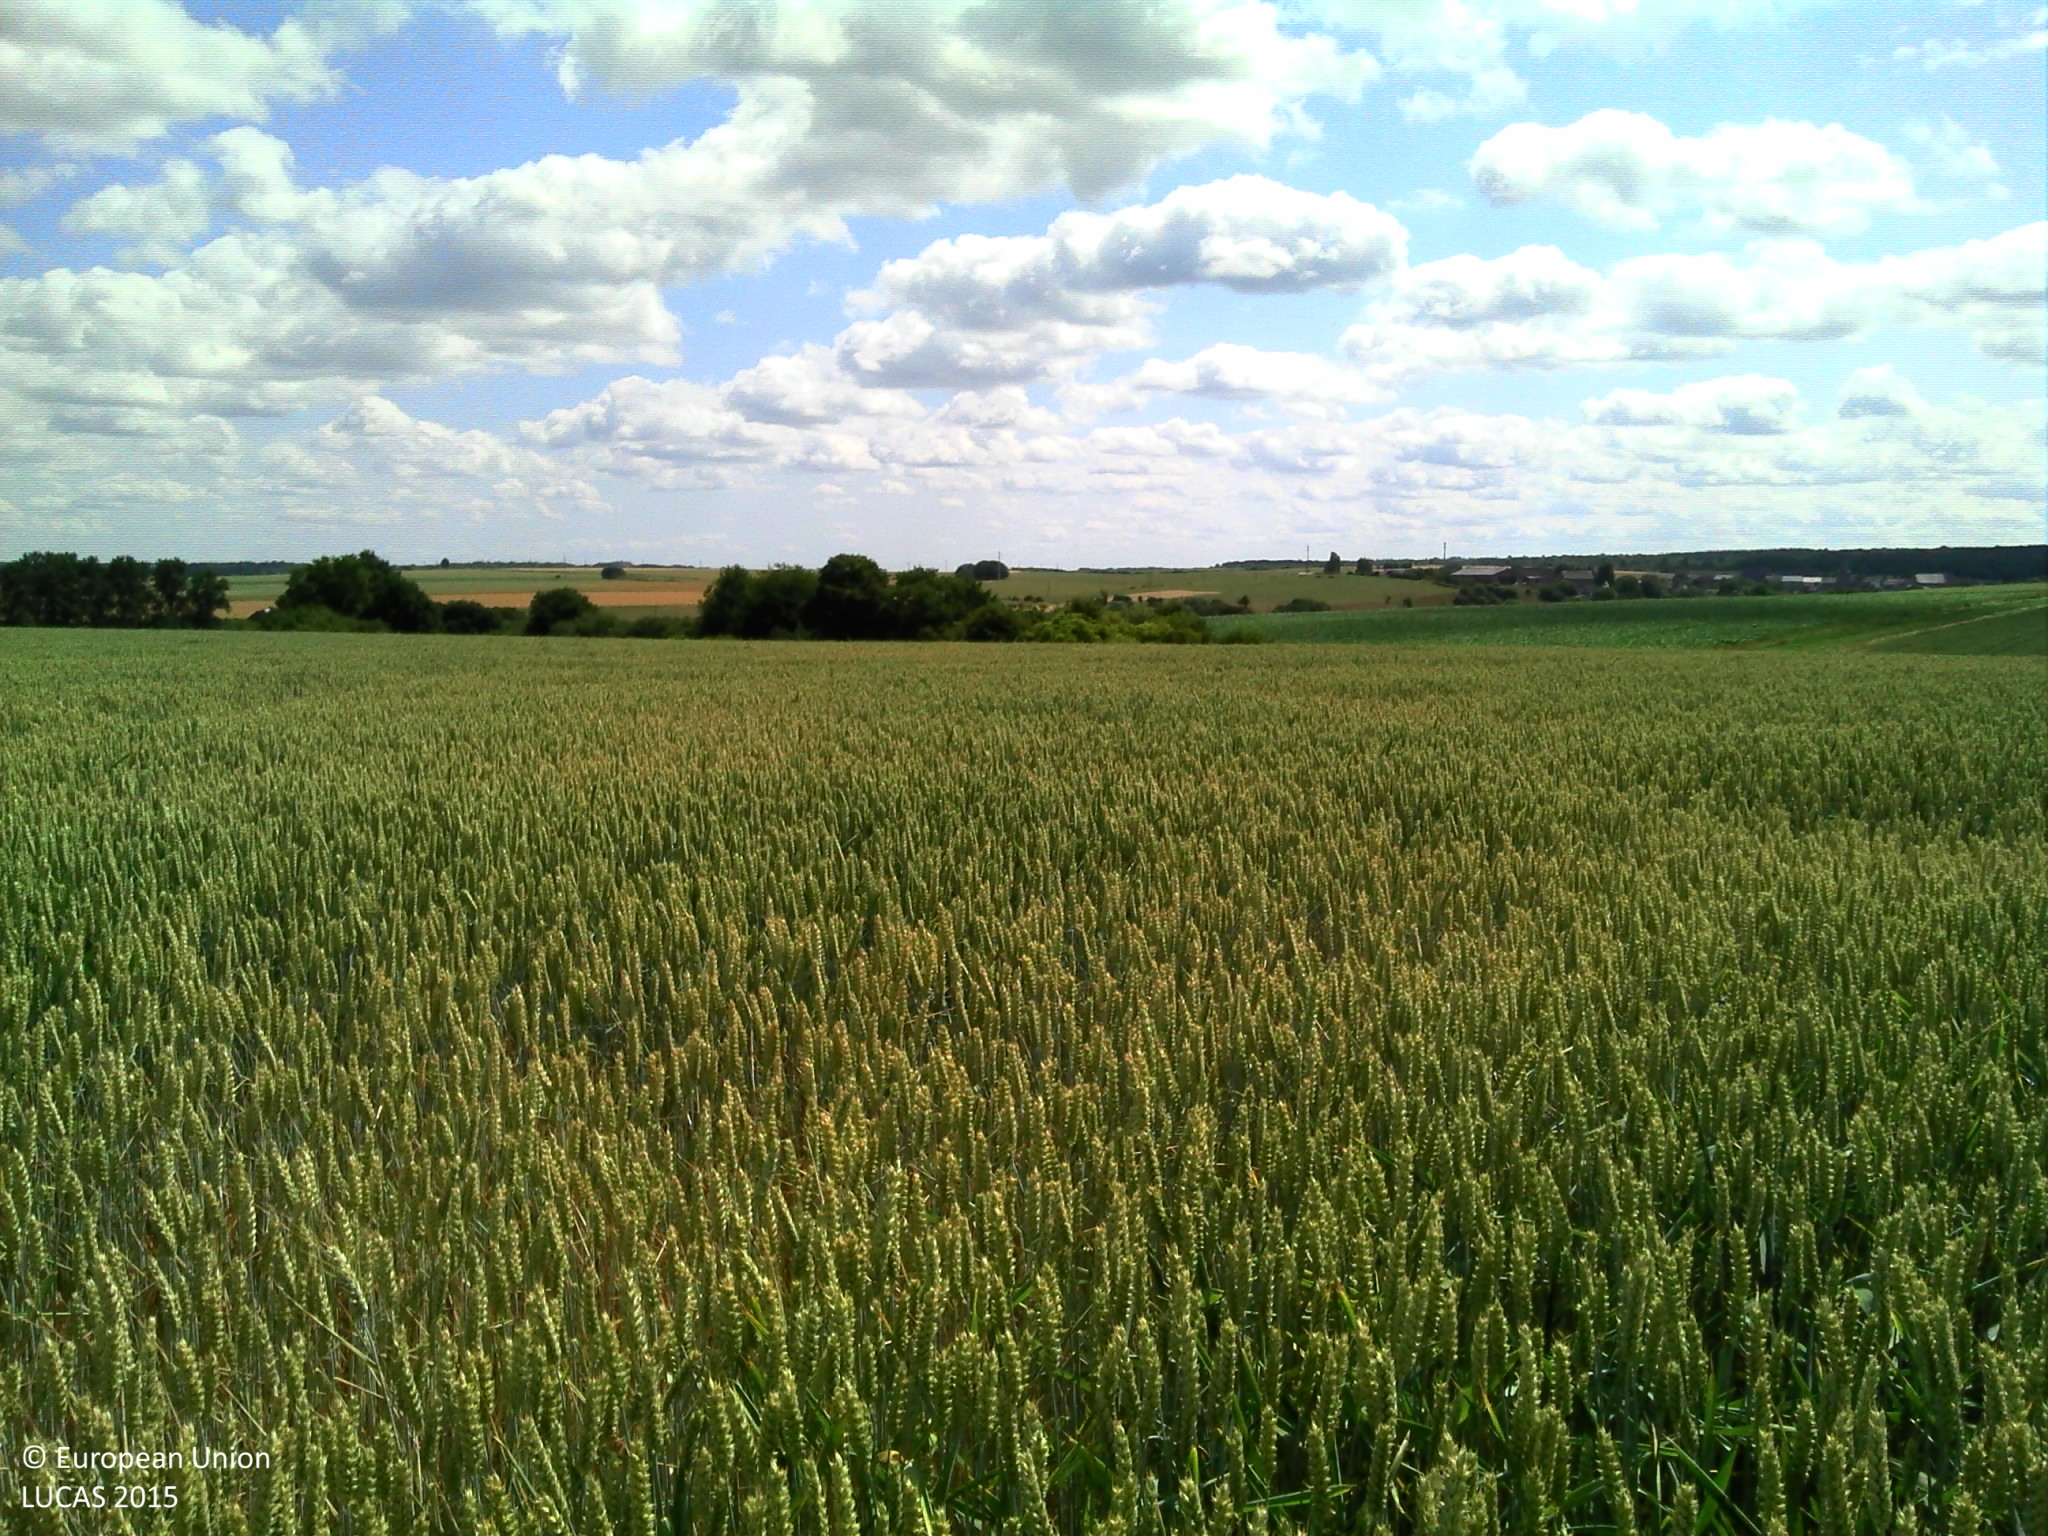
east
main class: Cropland
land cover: Common wheat
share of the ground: > 75 %
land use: Agriculture (excluding fallow land and kitchen gardens)
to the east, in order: Common wheat; Broadleaved woodland; Tracks; Grassland without tree/shrub cover; Fences; Grassland without tree/shrub cover; Fences; Broadleaved woodland
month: July
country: BE
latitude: 50.2338
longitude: 4.5425
